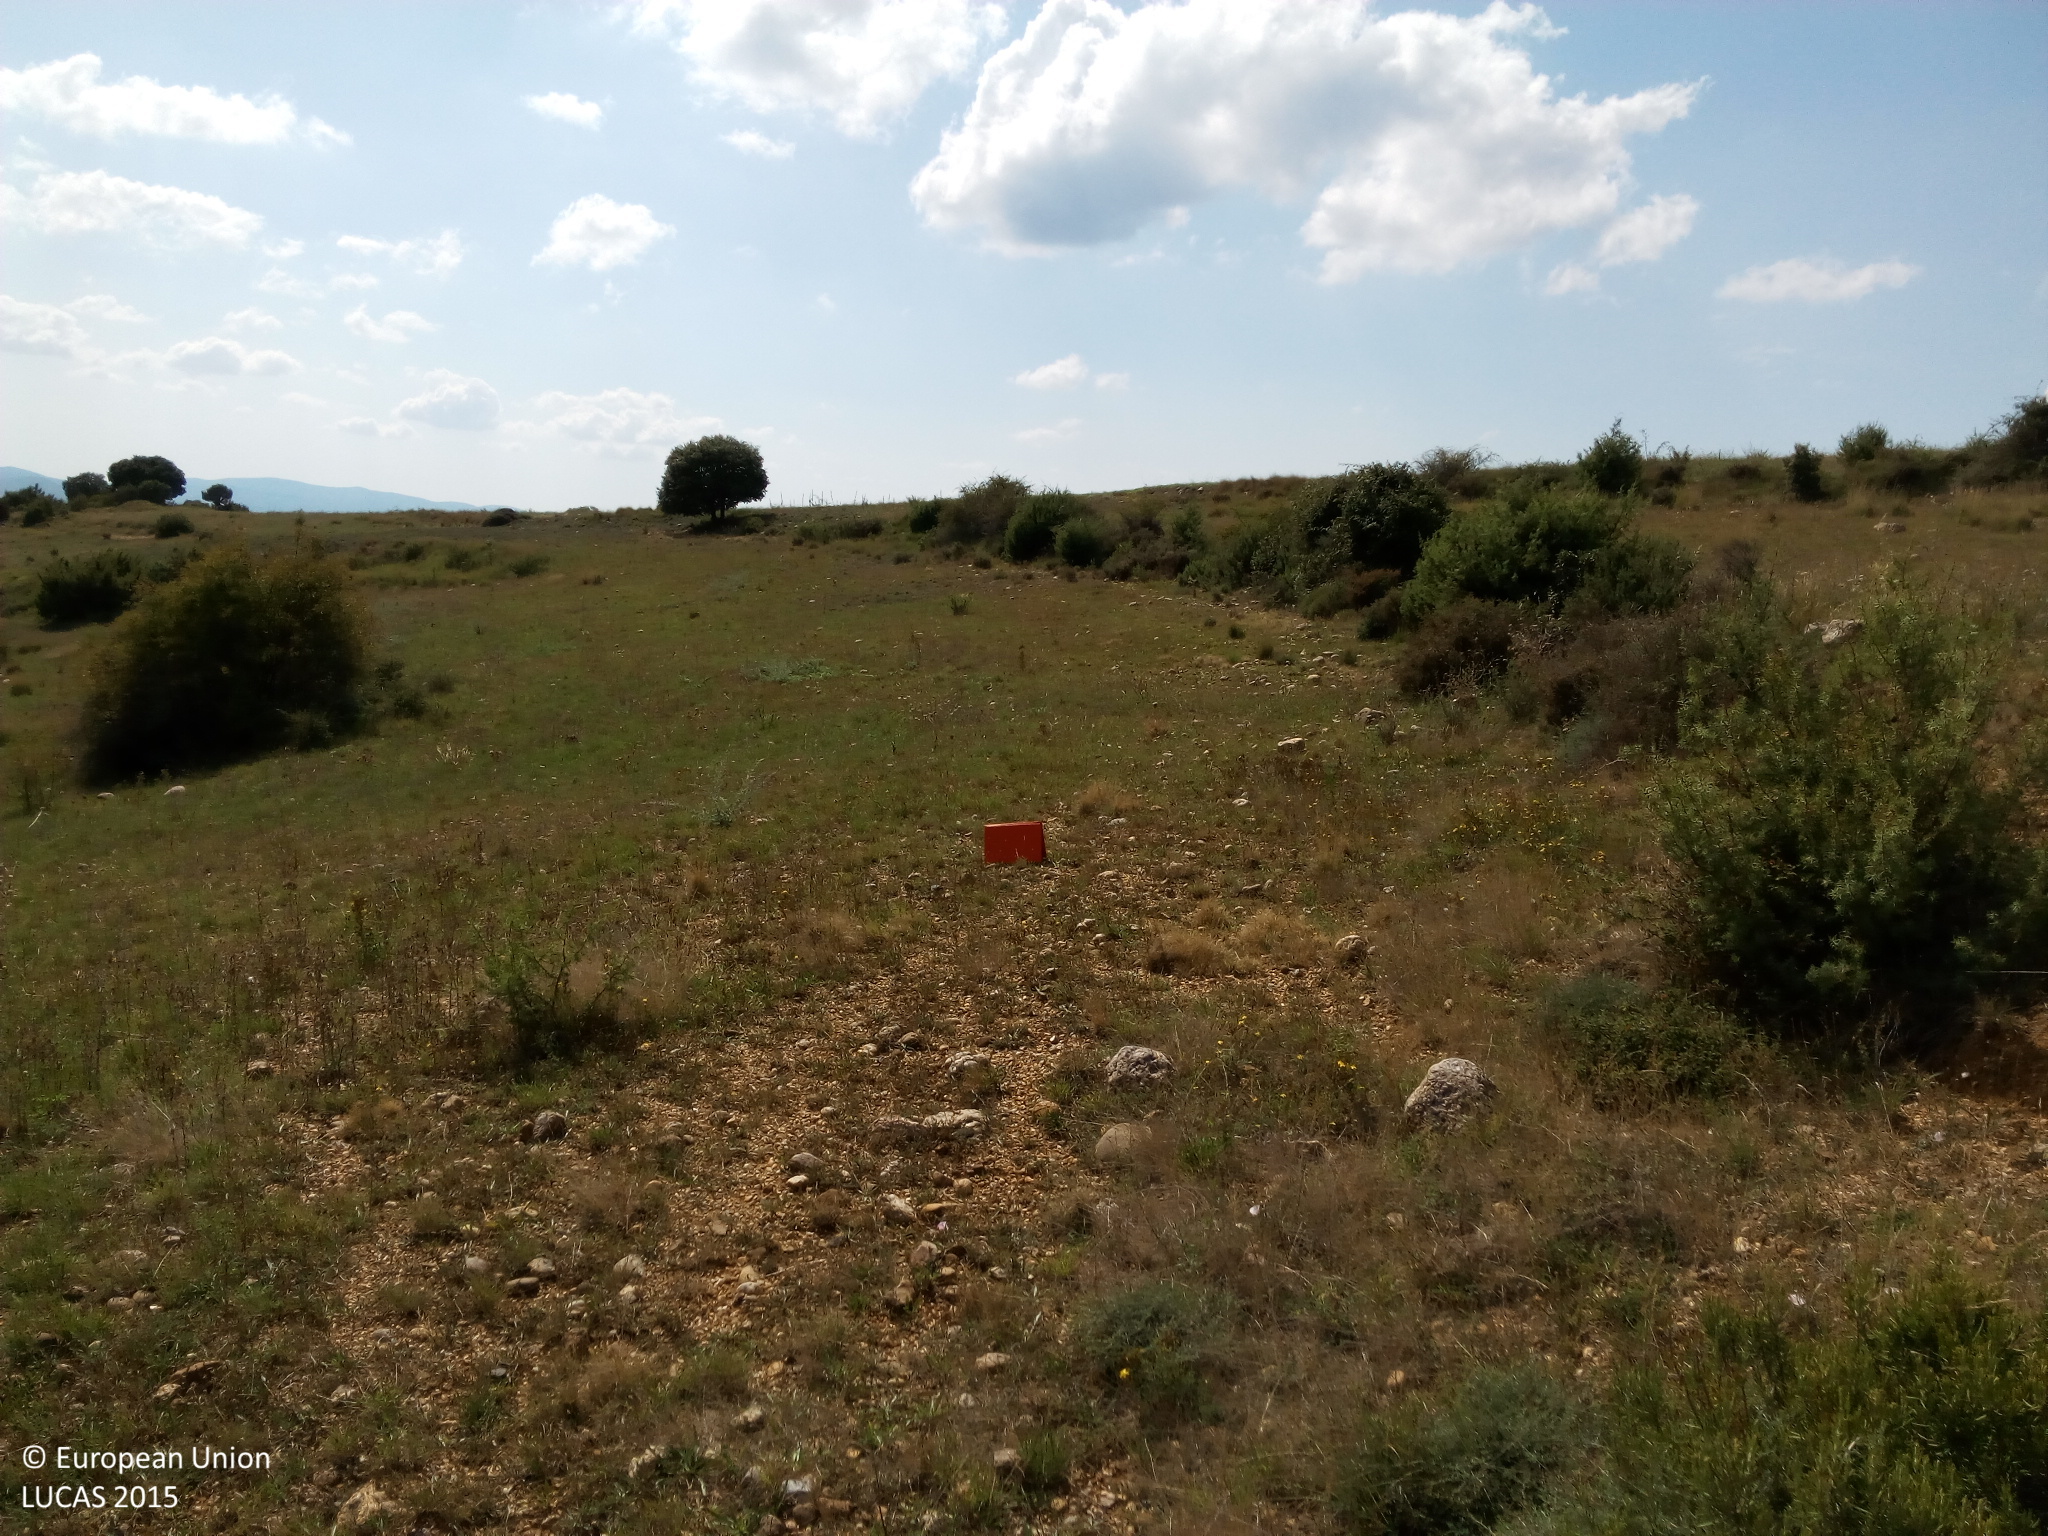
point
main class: Grassland
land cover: Grassland without tree/shrub cover
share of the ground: > 75 %
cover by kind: unconsolidated bare surface 60 %, herbaceous plants 40 %
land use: Semi-natural and natural areas not in use
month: August
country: ES
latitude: 42.1550
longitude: 0.5312
